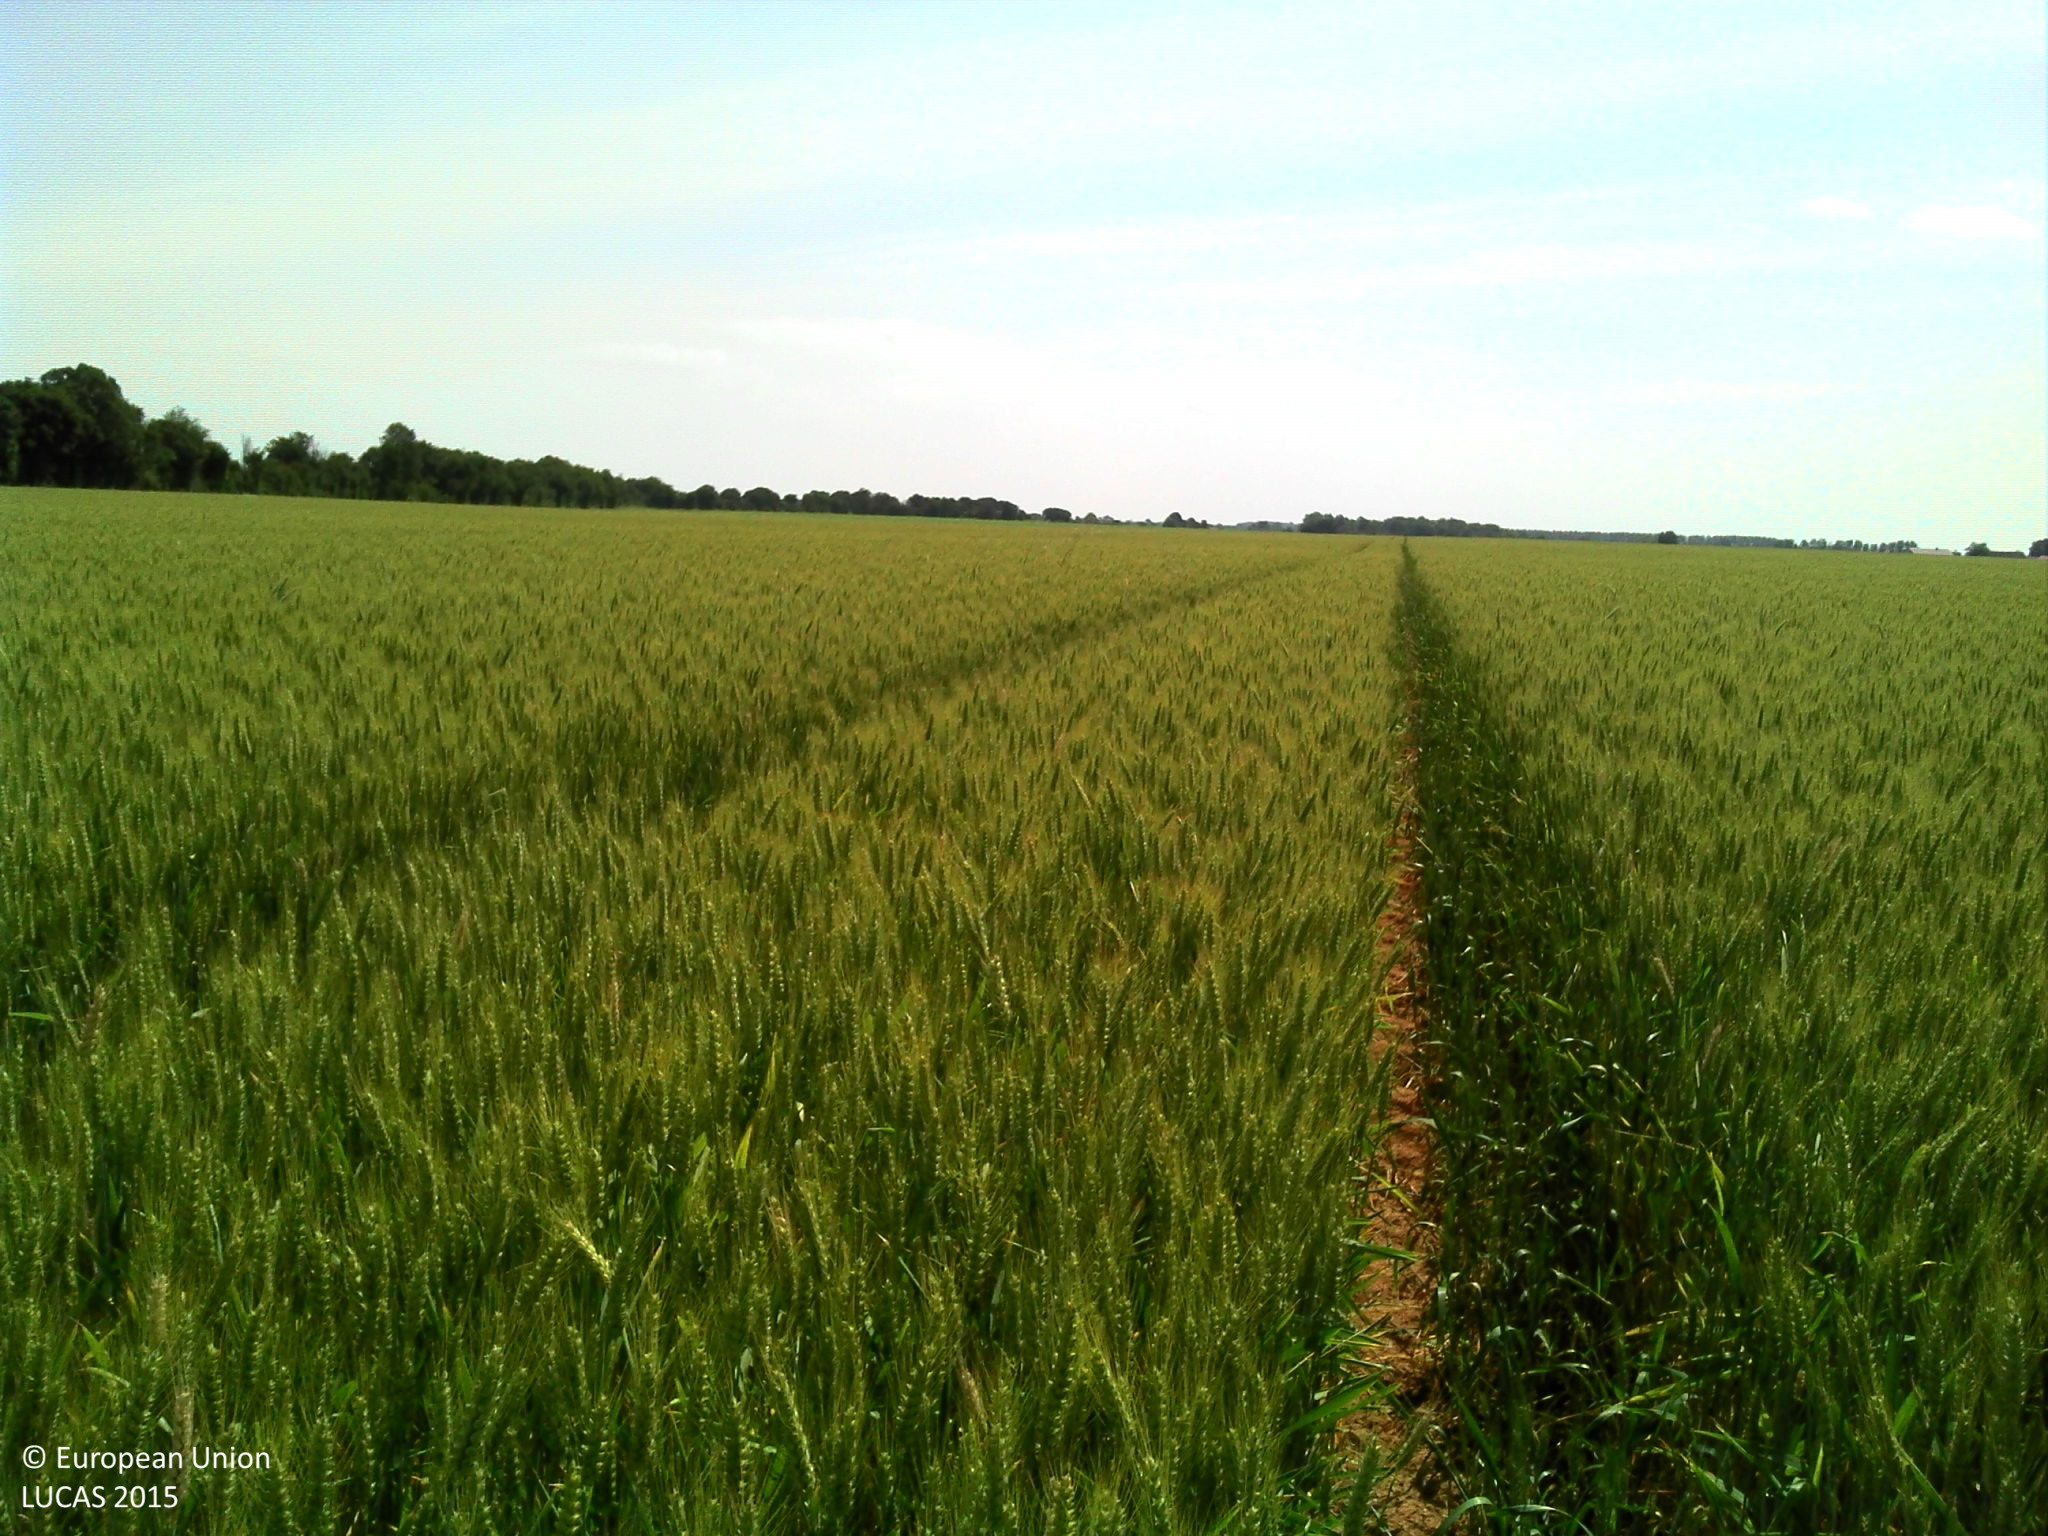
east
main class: Cropland
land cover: Common wheat
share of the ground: > 75 %
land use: Agriculture (excluding fallow land and kitchen gardens)
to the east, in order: Common wheat
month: June
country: FR
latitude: 46.9658
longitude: 2.6474
